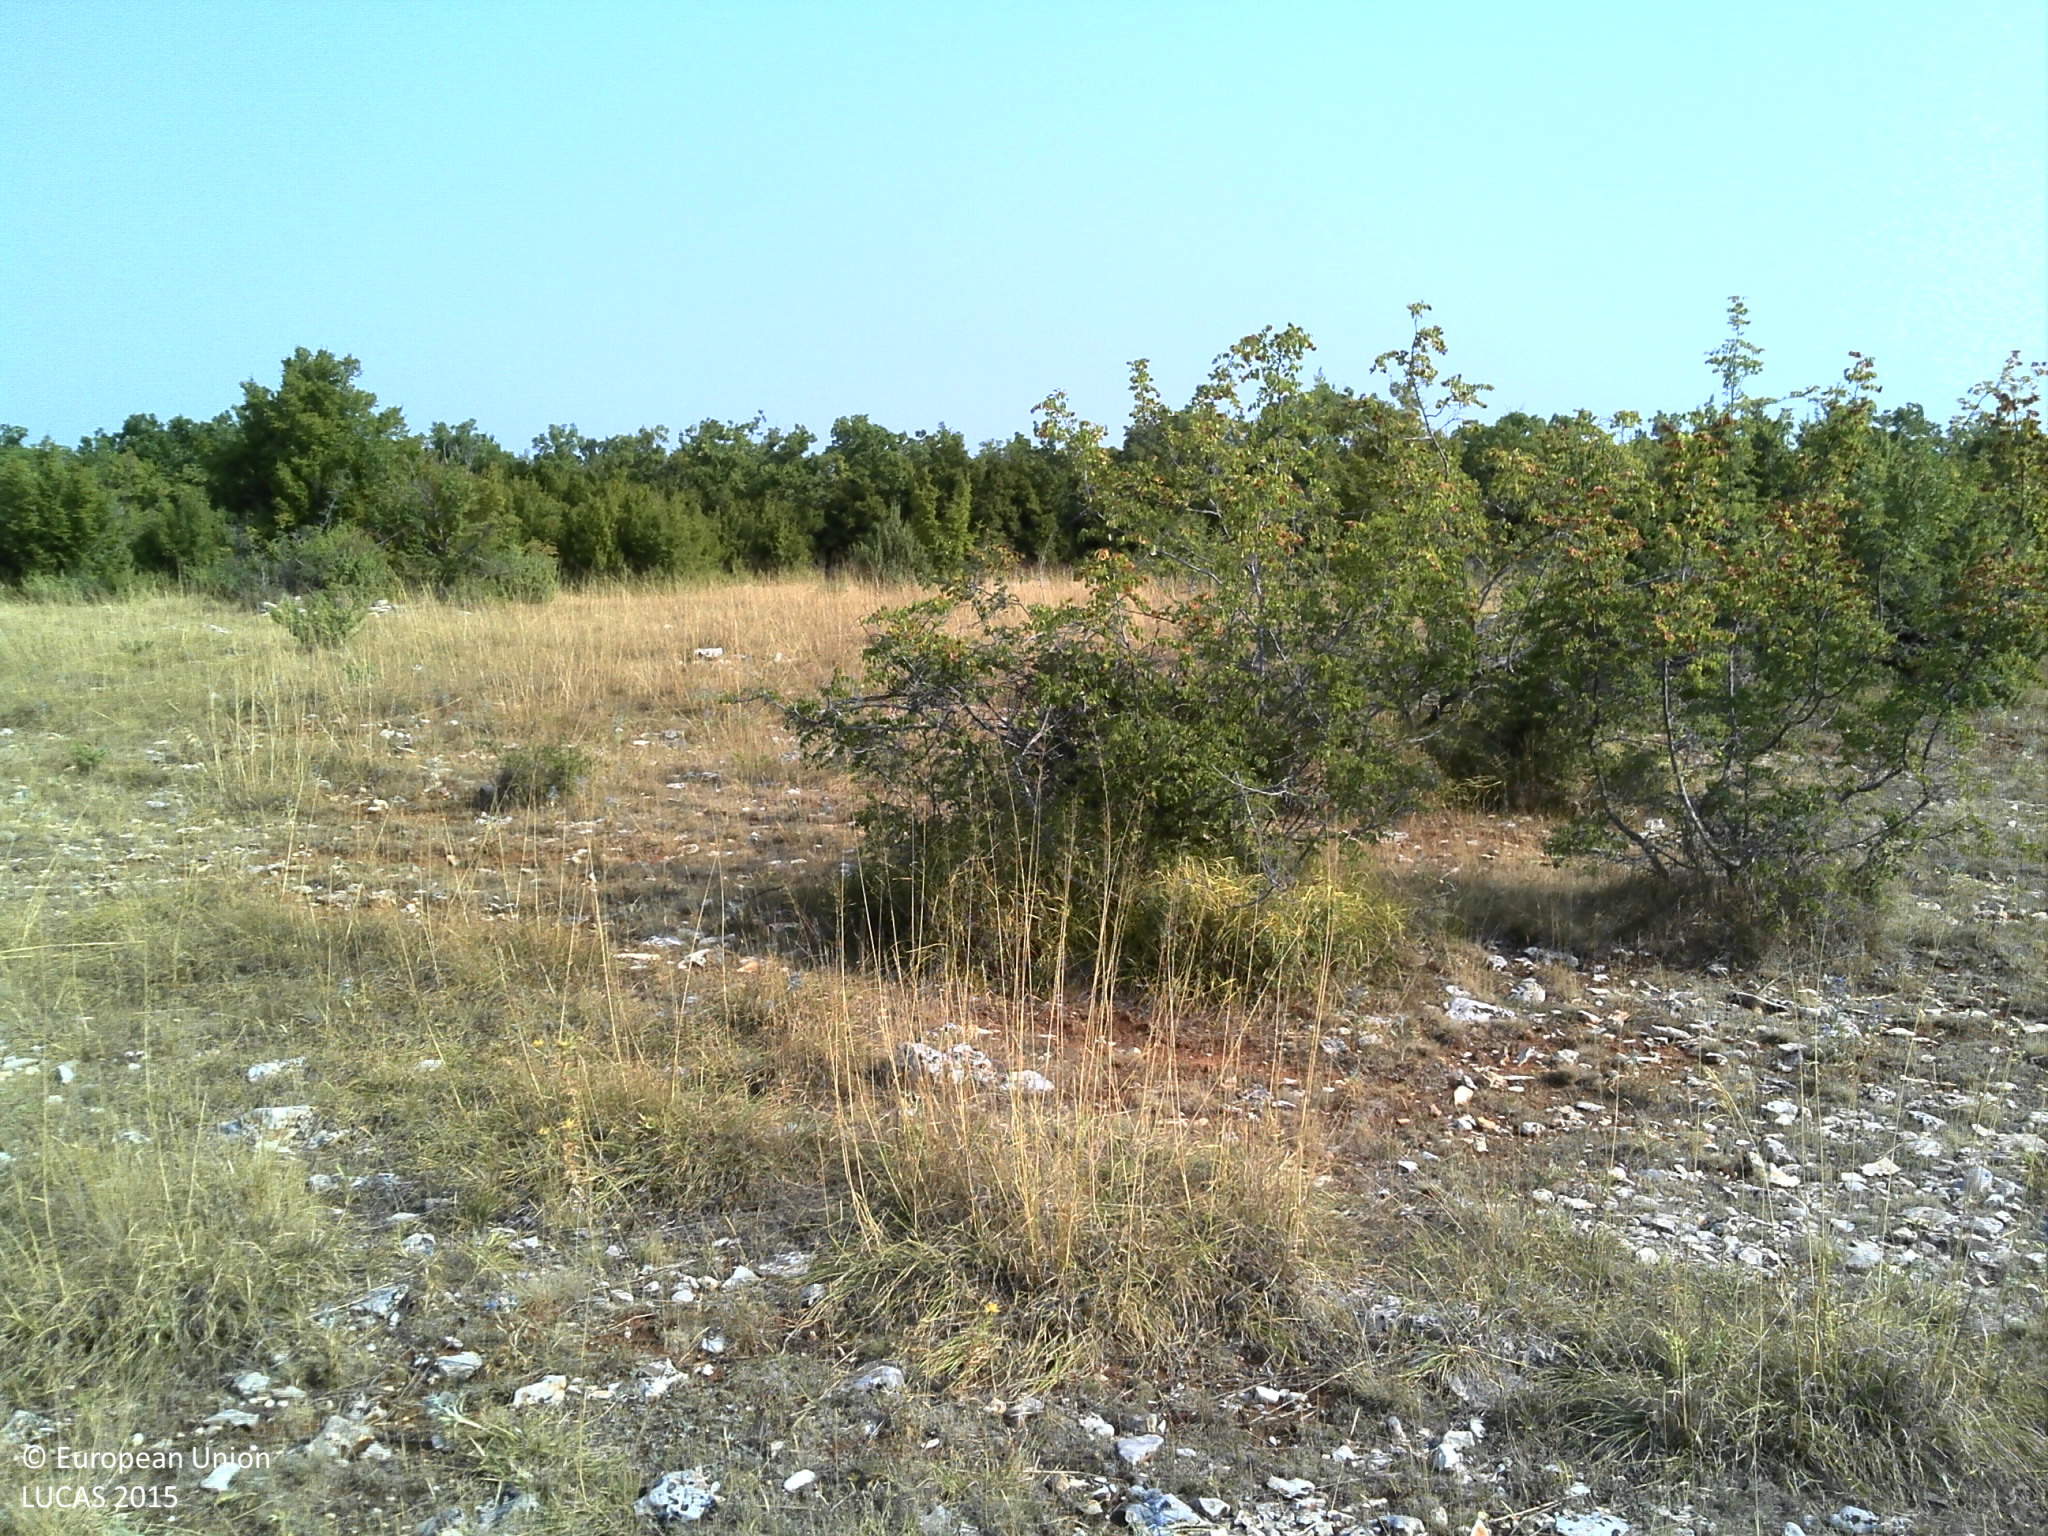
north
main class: Grassland
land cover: Grassland with sparse tree/shrub cover
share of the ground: > 75 %
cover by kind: herbaceous plants 65 %, unconsolidated bare surface 20 %, shrubs 10 %, broadleaved forest trees 5 %
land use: Semi-natural and natural areas not in use
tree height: < 5 m
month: August
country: HR
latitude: 44.0189
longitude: 15.9177
